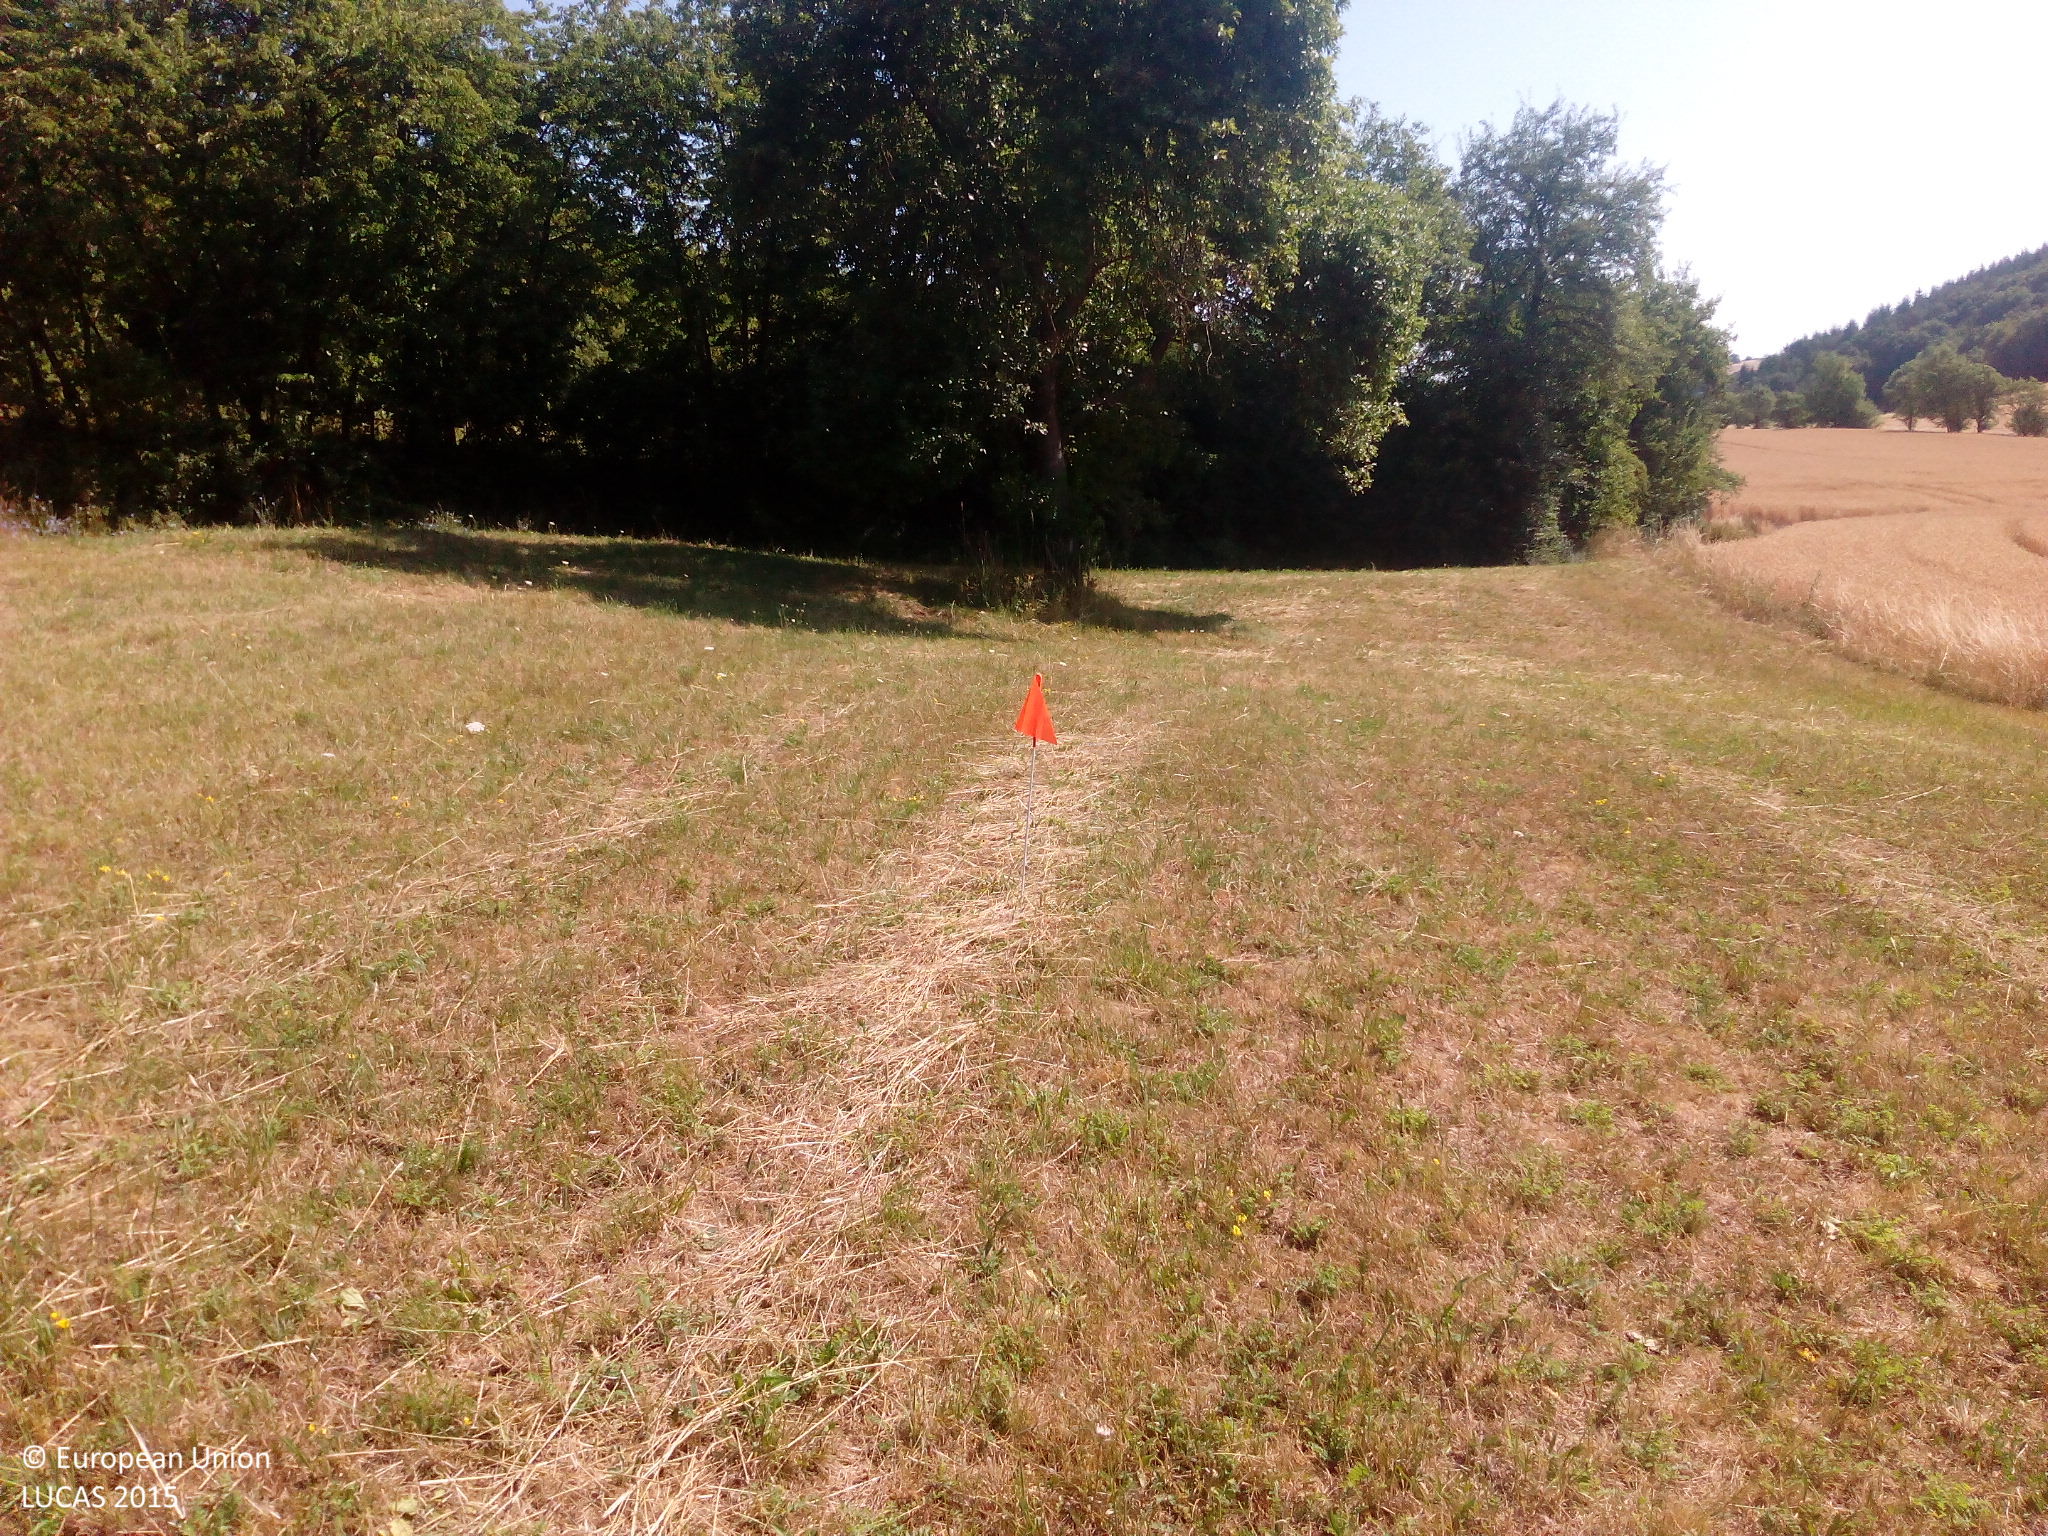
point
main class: Grassland
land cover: Grassland without tree/shrub cover
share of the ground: > 75 %
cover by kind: herbaceous plants 95 %, unconsolidated bare surface 5 %
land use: Agriculture (excluding fallow land and kitchen gardens)
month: July
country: DE
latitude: 49.7452
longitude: 7.5996
